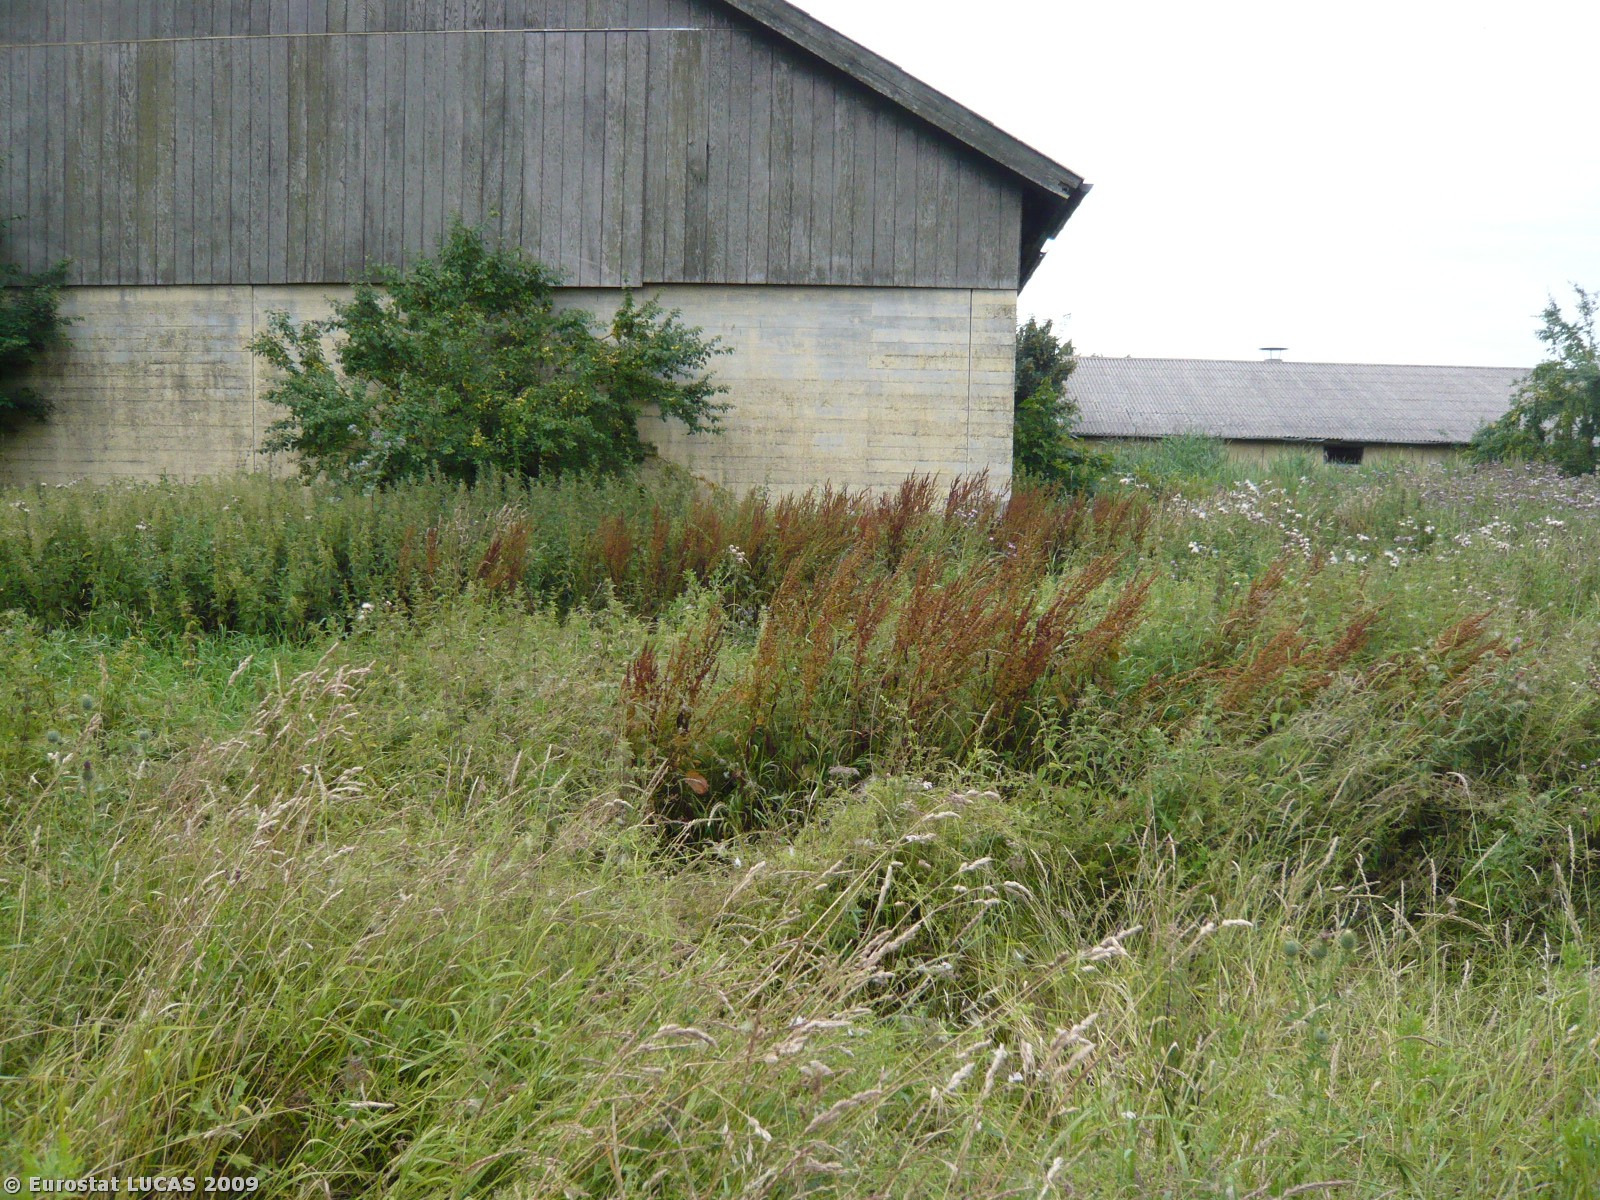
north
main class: Grassland
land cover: Spontaneously vegetated surfaces
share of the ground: > 75 %
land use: Residential
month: July
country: DK
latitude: 55.8994
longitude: 12.1890
